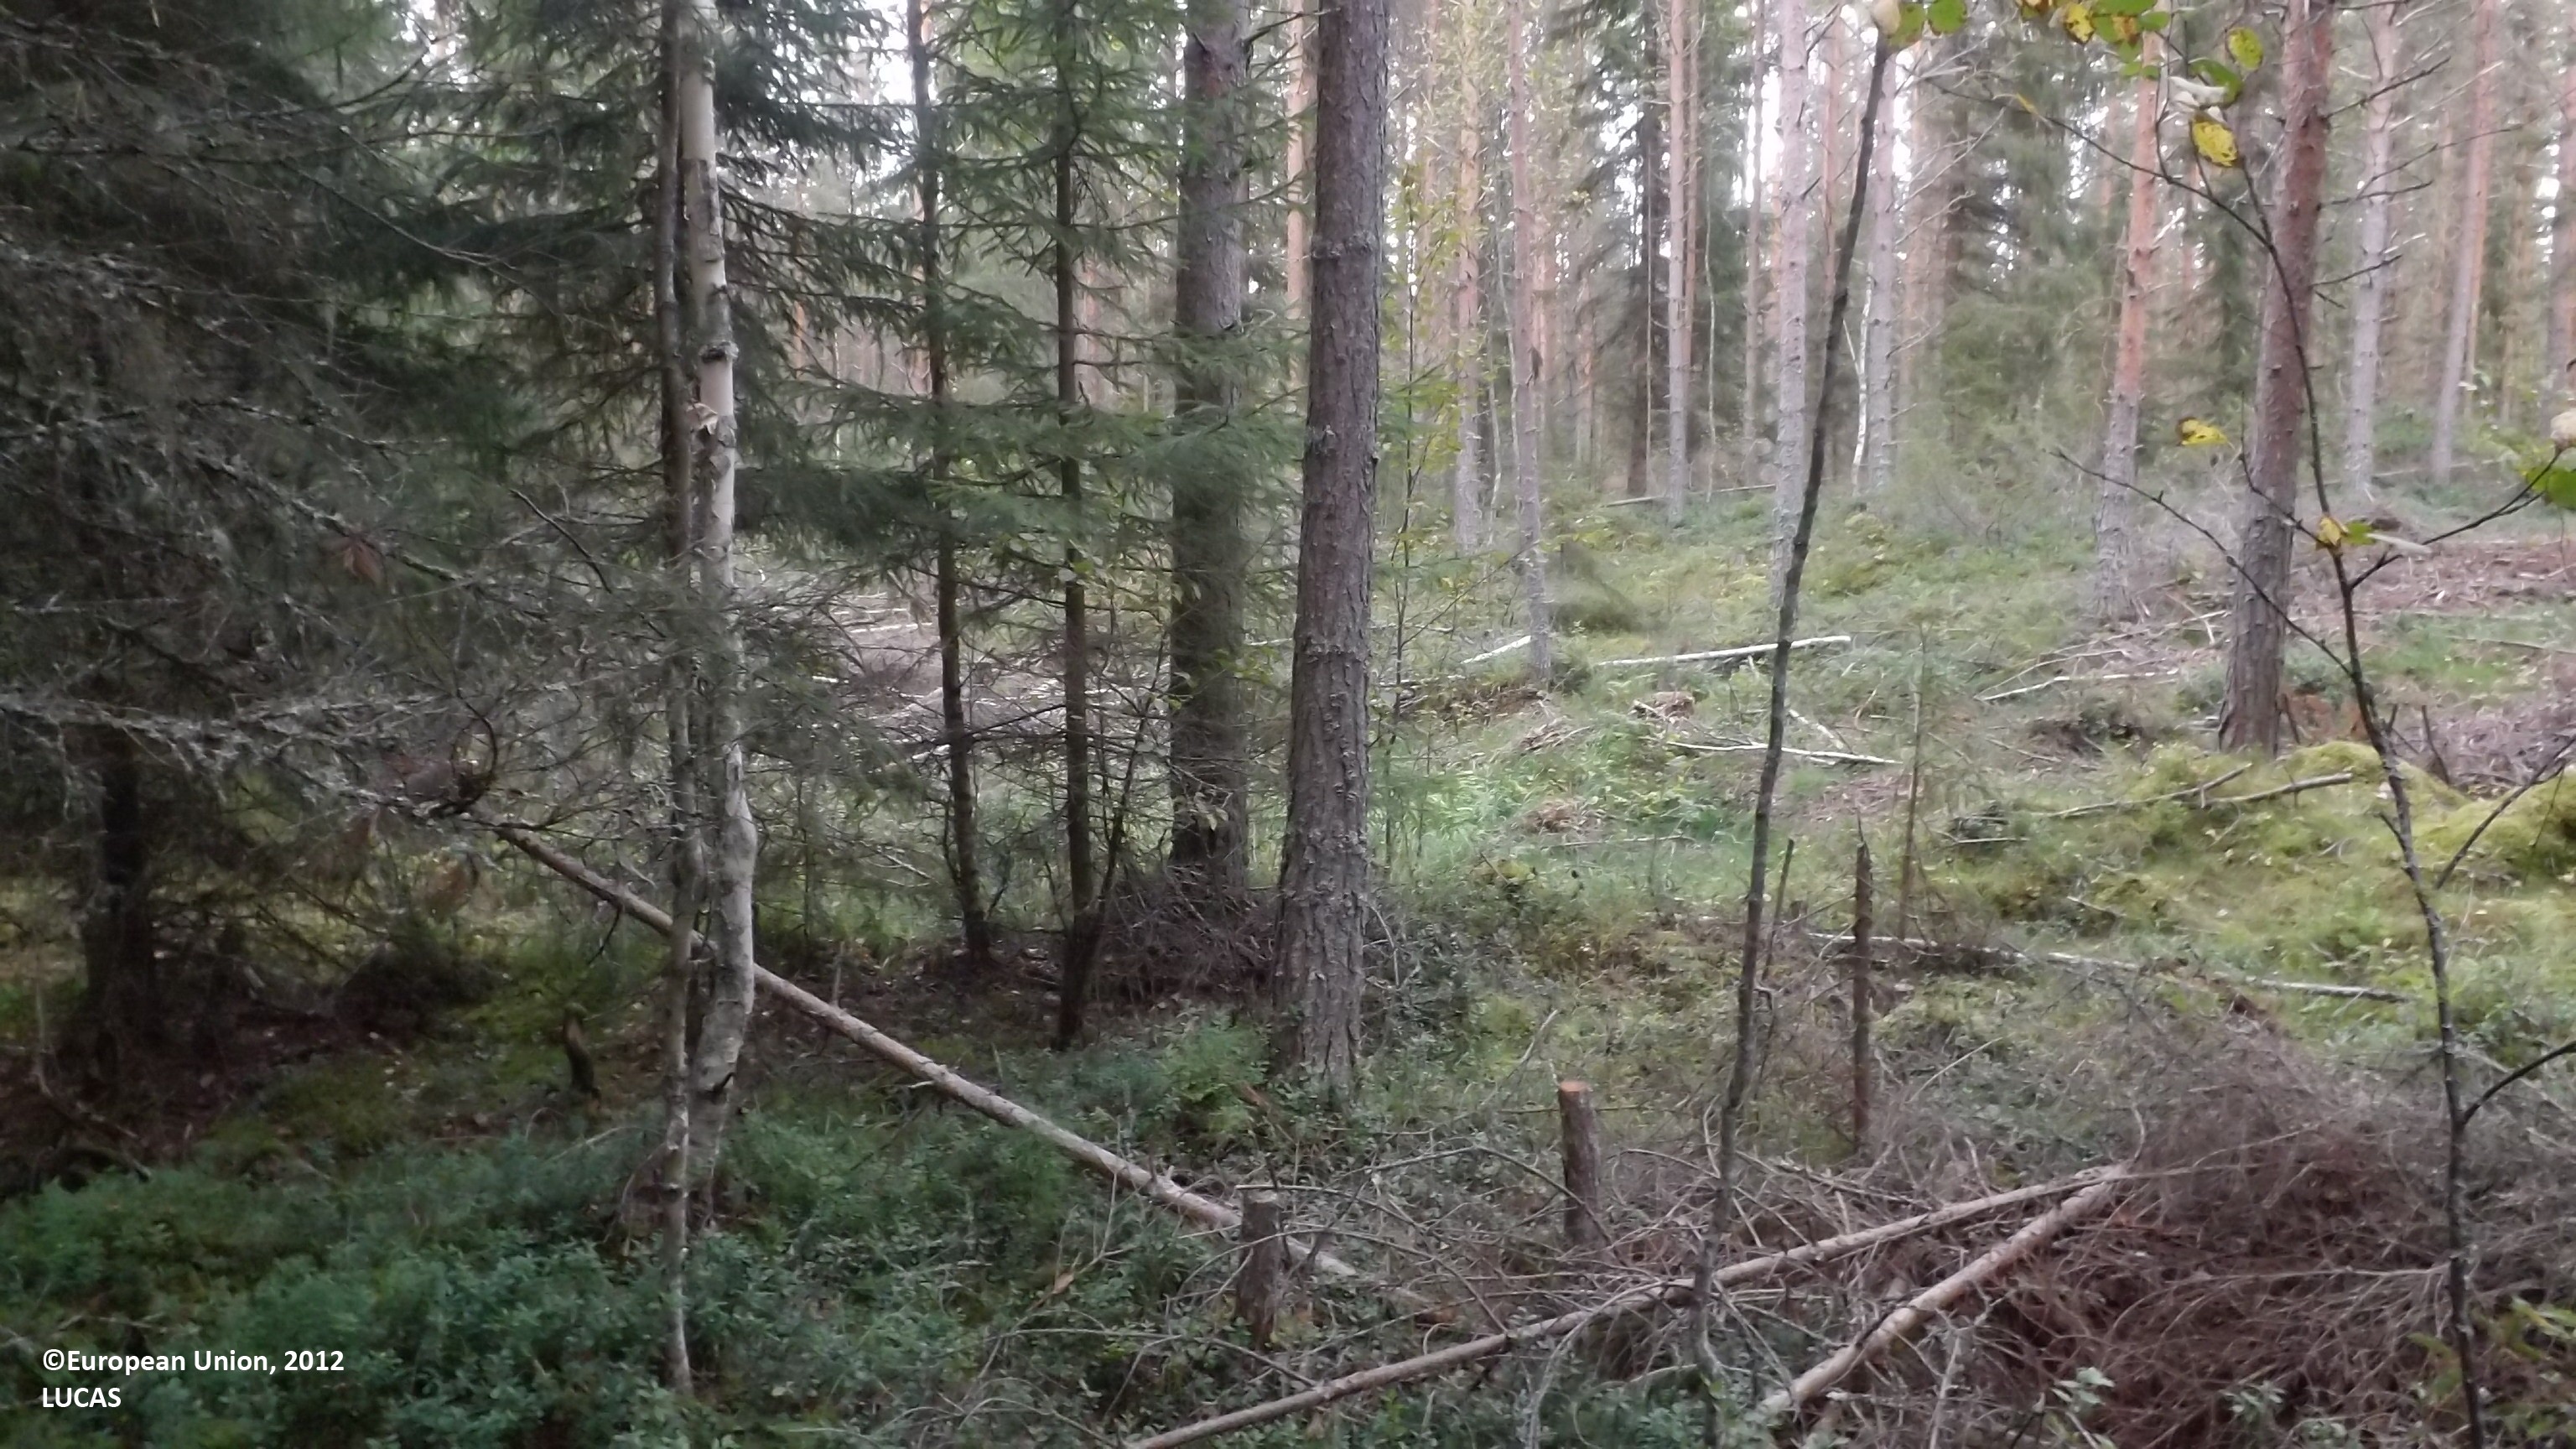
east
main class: Woodland
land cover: Pine dominated mixed woodland
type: boreal forest
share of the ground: 50 - 75 %
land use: Forestry
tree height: > 5 m
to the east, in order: Pine dominated mixed woodland; Pine dominated coniferous woodland; Pine dominated mixed woodland; Tracks; Pine dominated mixed woodland; Pine dominated coniferous woodland
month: August
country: FI
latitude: 63.8227
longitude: 23.4470
